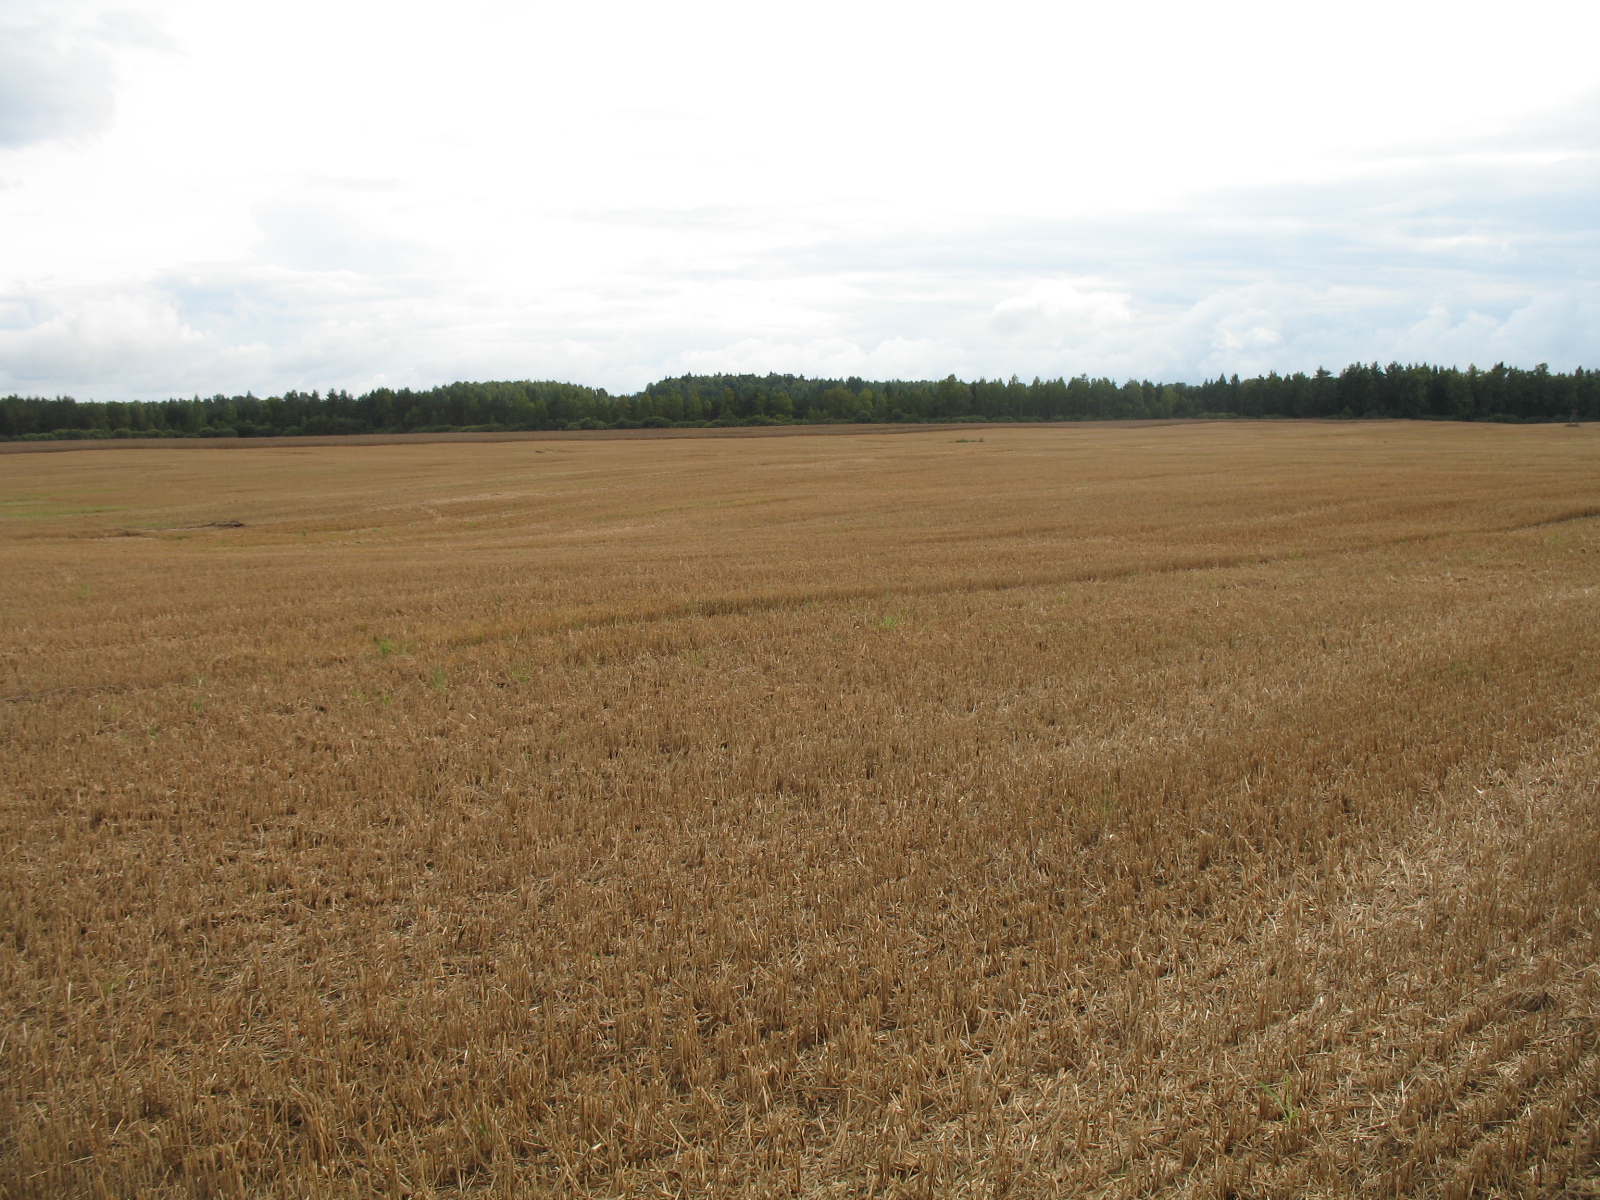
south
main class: Cropland
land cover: Common wheat
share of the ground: < 10 %
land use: Agriculture (excluding fallow land and kitchen gardens)
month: September
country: LV
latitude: 56.0872
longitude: 25.8983
